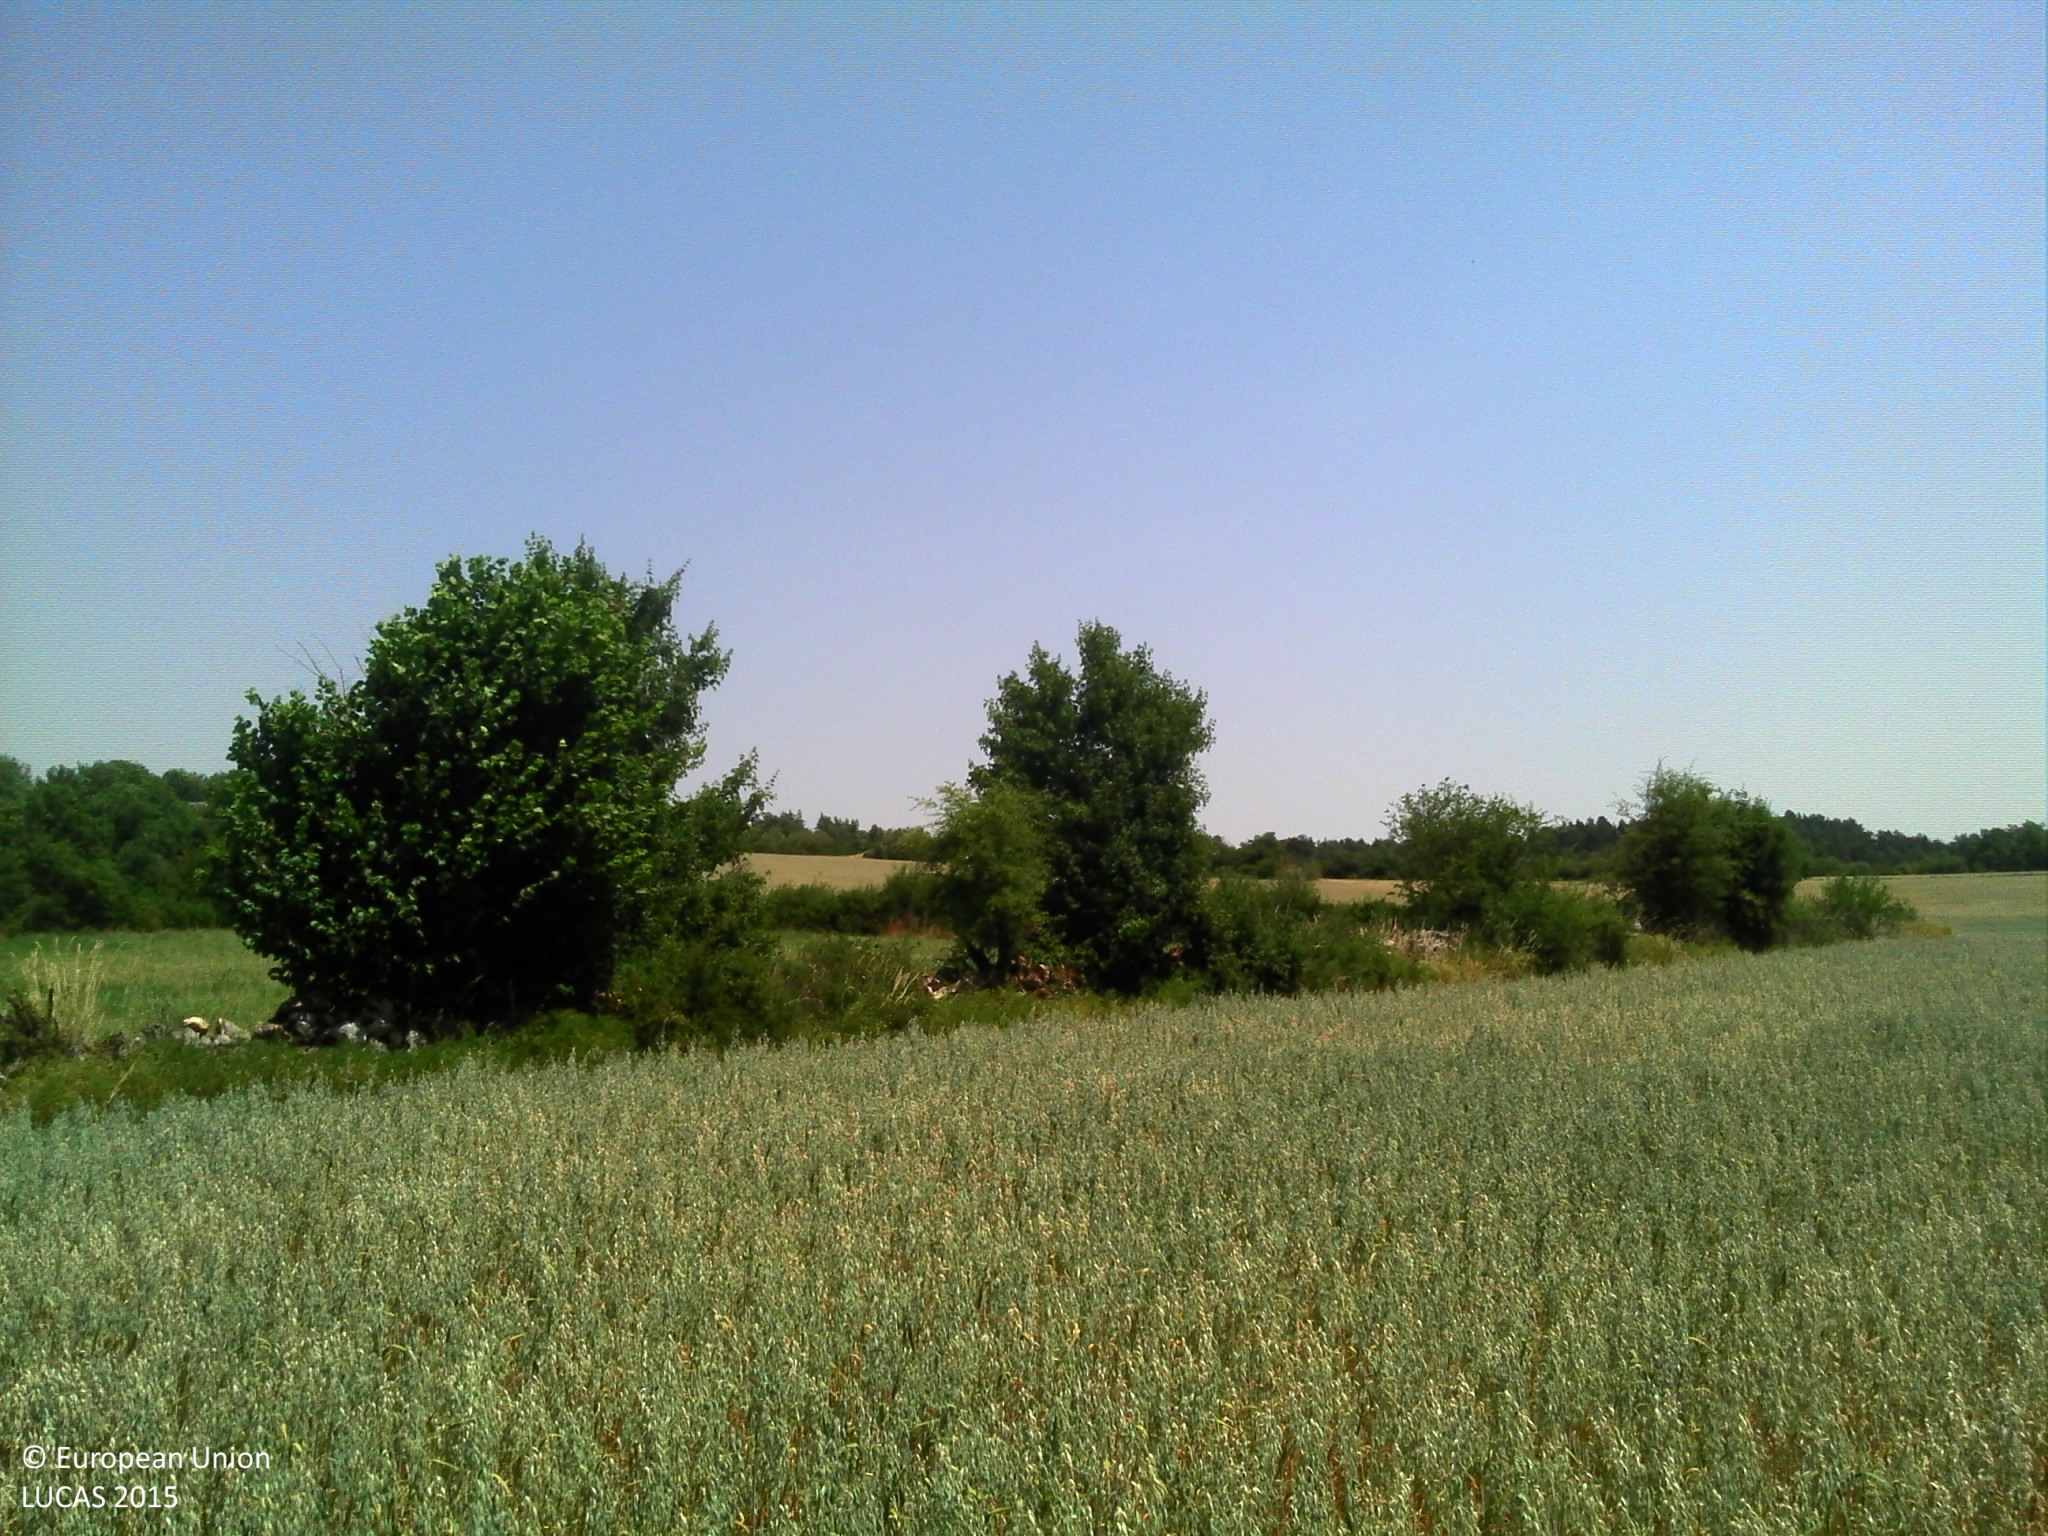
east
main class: Cropland
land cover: Oats
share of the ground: > 75 %
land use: Agriculture (excluding fallow land and kitchen gardens)
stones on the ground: 25 - 50 %
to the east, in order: Oats; Managed hedges; Dry stone walls; Lucerne; Dry stone walls; Managed hedges; Tracks; Oats; Temporary grasslands
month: July
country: FR
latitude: 44.3131
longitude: 3.2731
